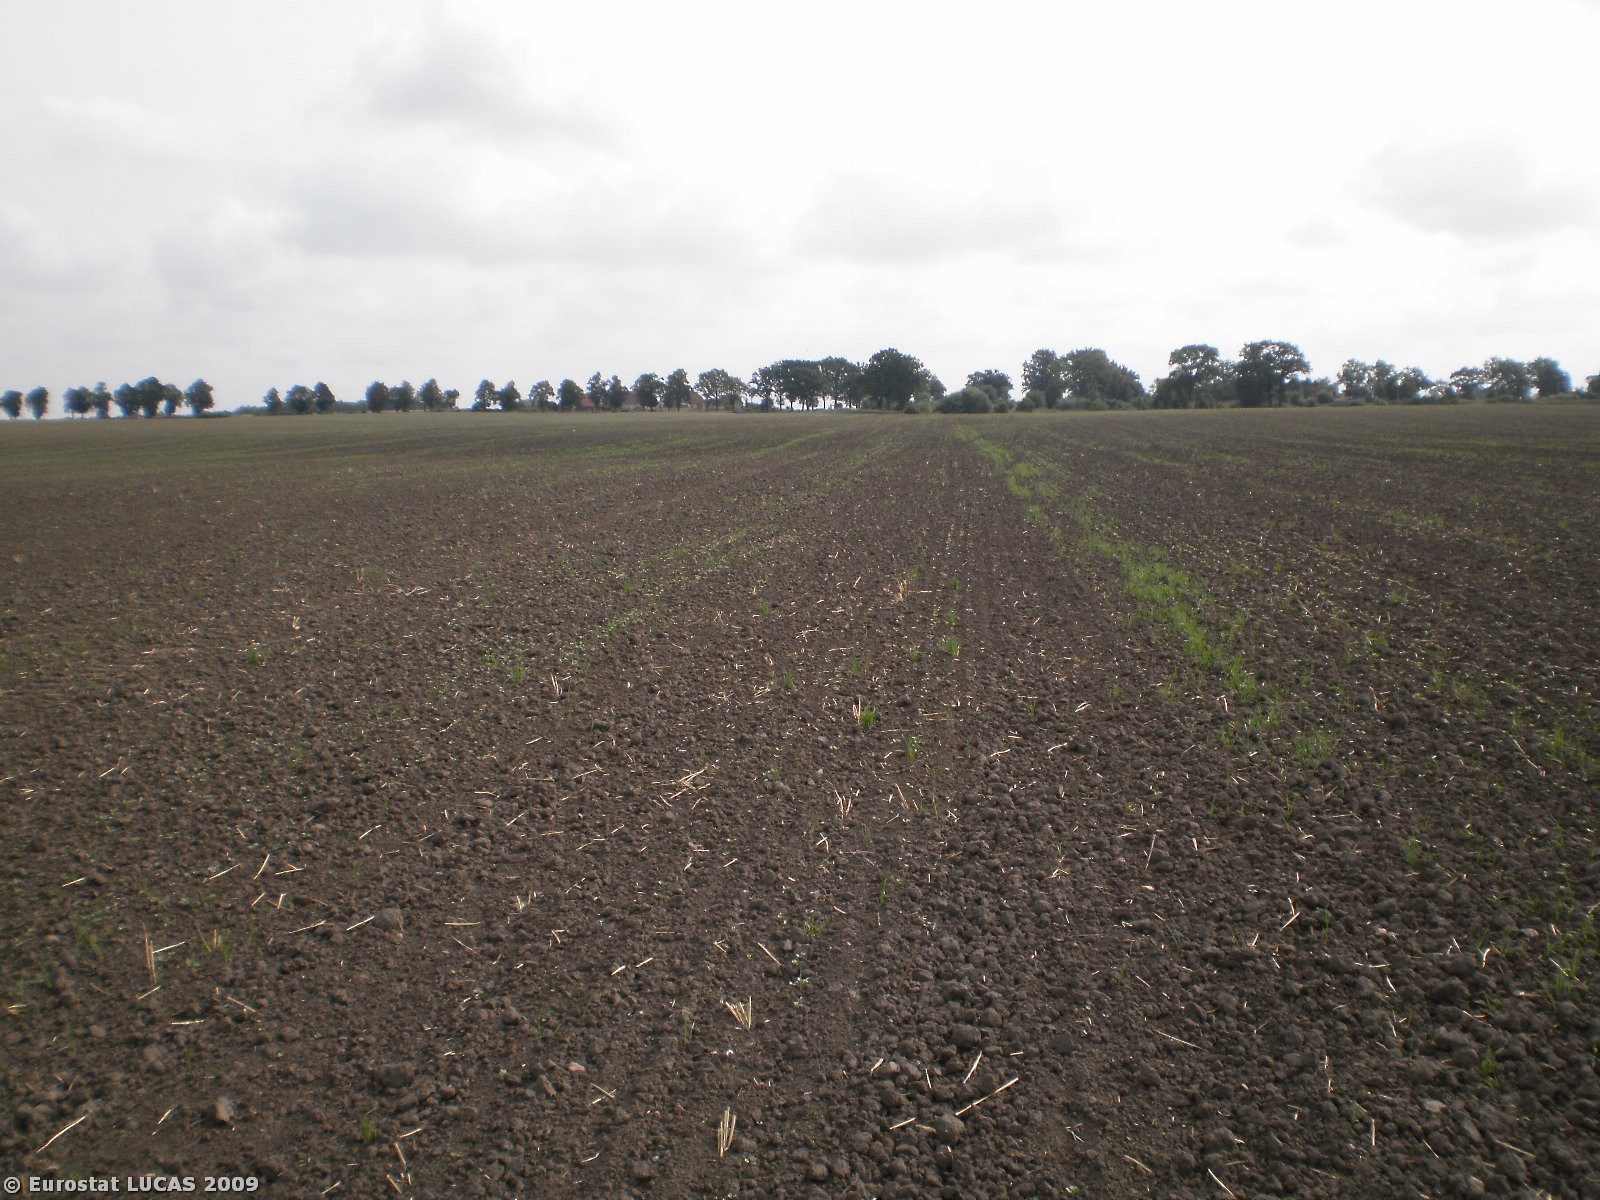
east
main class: Cropland
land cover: Common wheat
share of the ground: < 10 %
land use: Agriculture (excluding fallow land and kitchen gardens)
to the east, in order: Common wheat
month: August
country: PL
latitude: 54.2192
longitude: 21.2565
